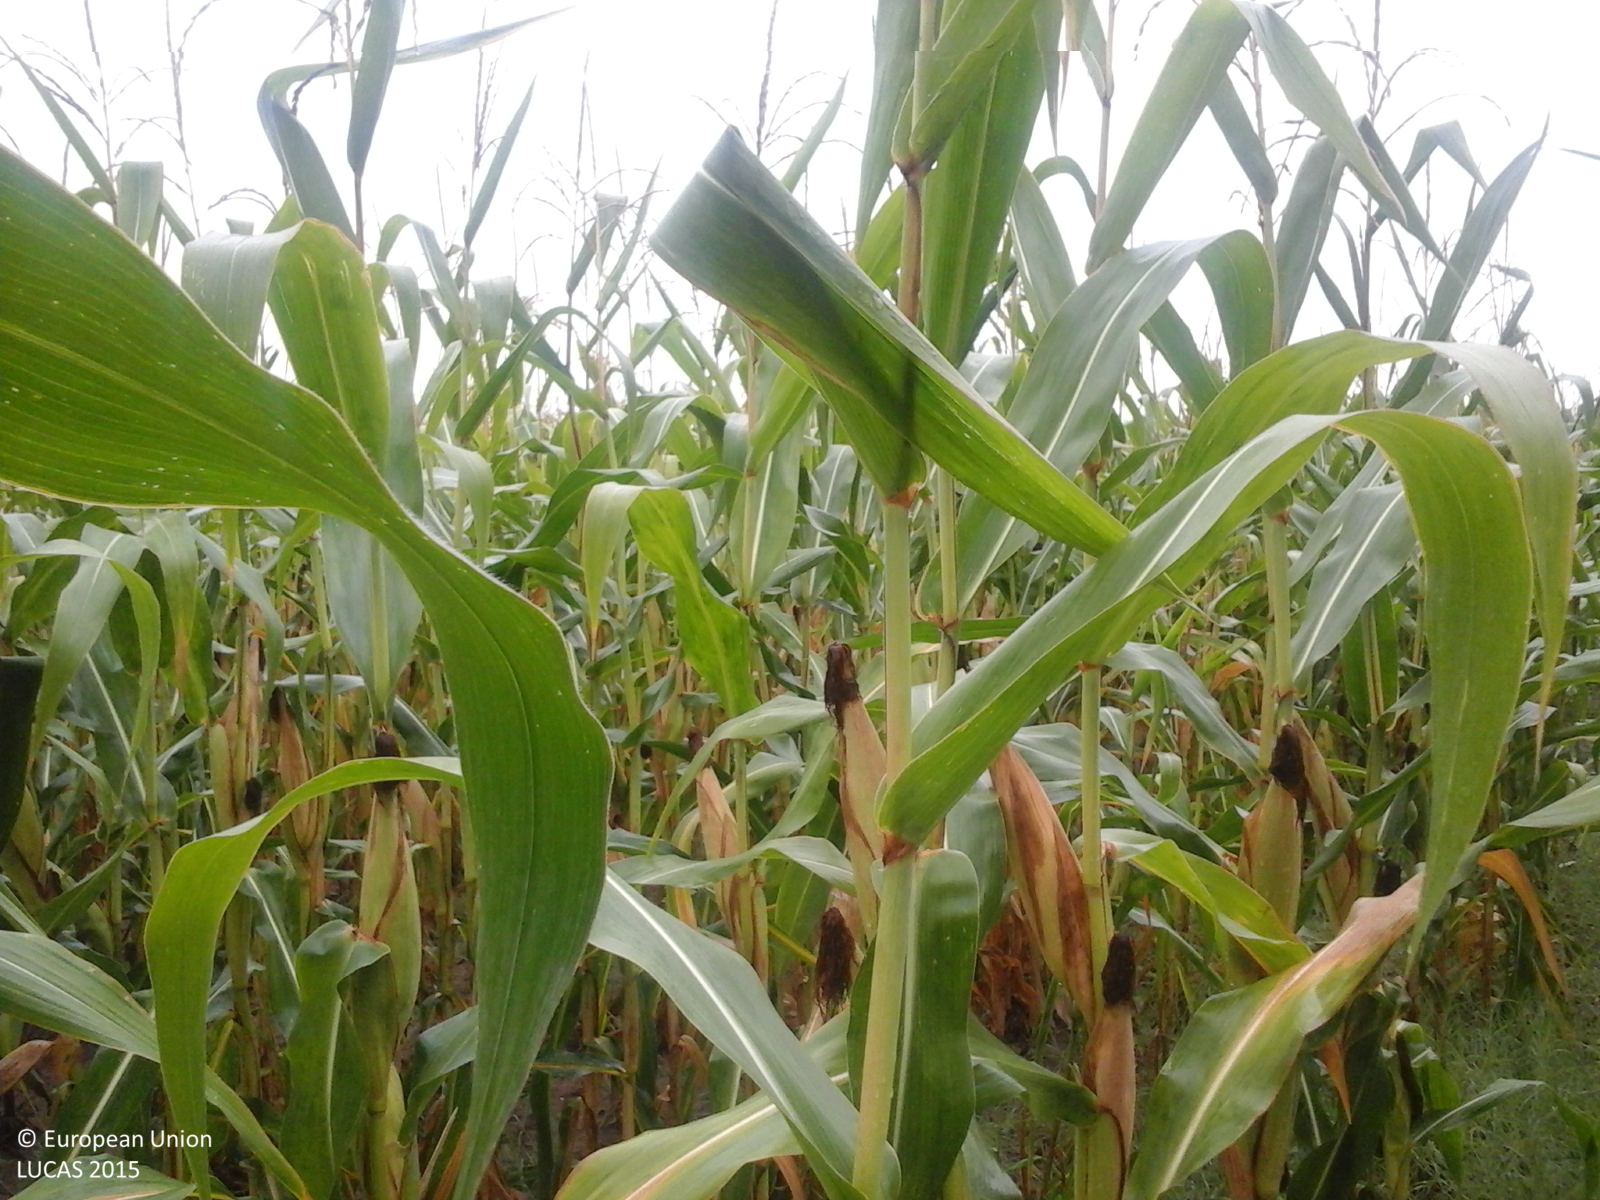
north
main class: Cropland
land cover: Maize
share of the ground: > 75 %
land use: Agriculture (excluding fallow land and kitchen gardens)
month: August
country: RO
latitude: 45.7587
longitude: 21.7232
